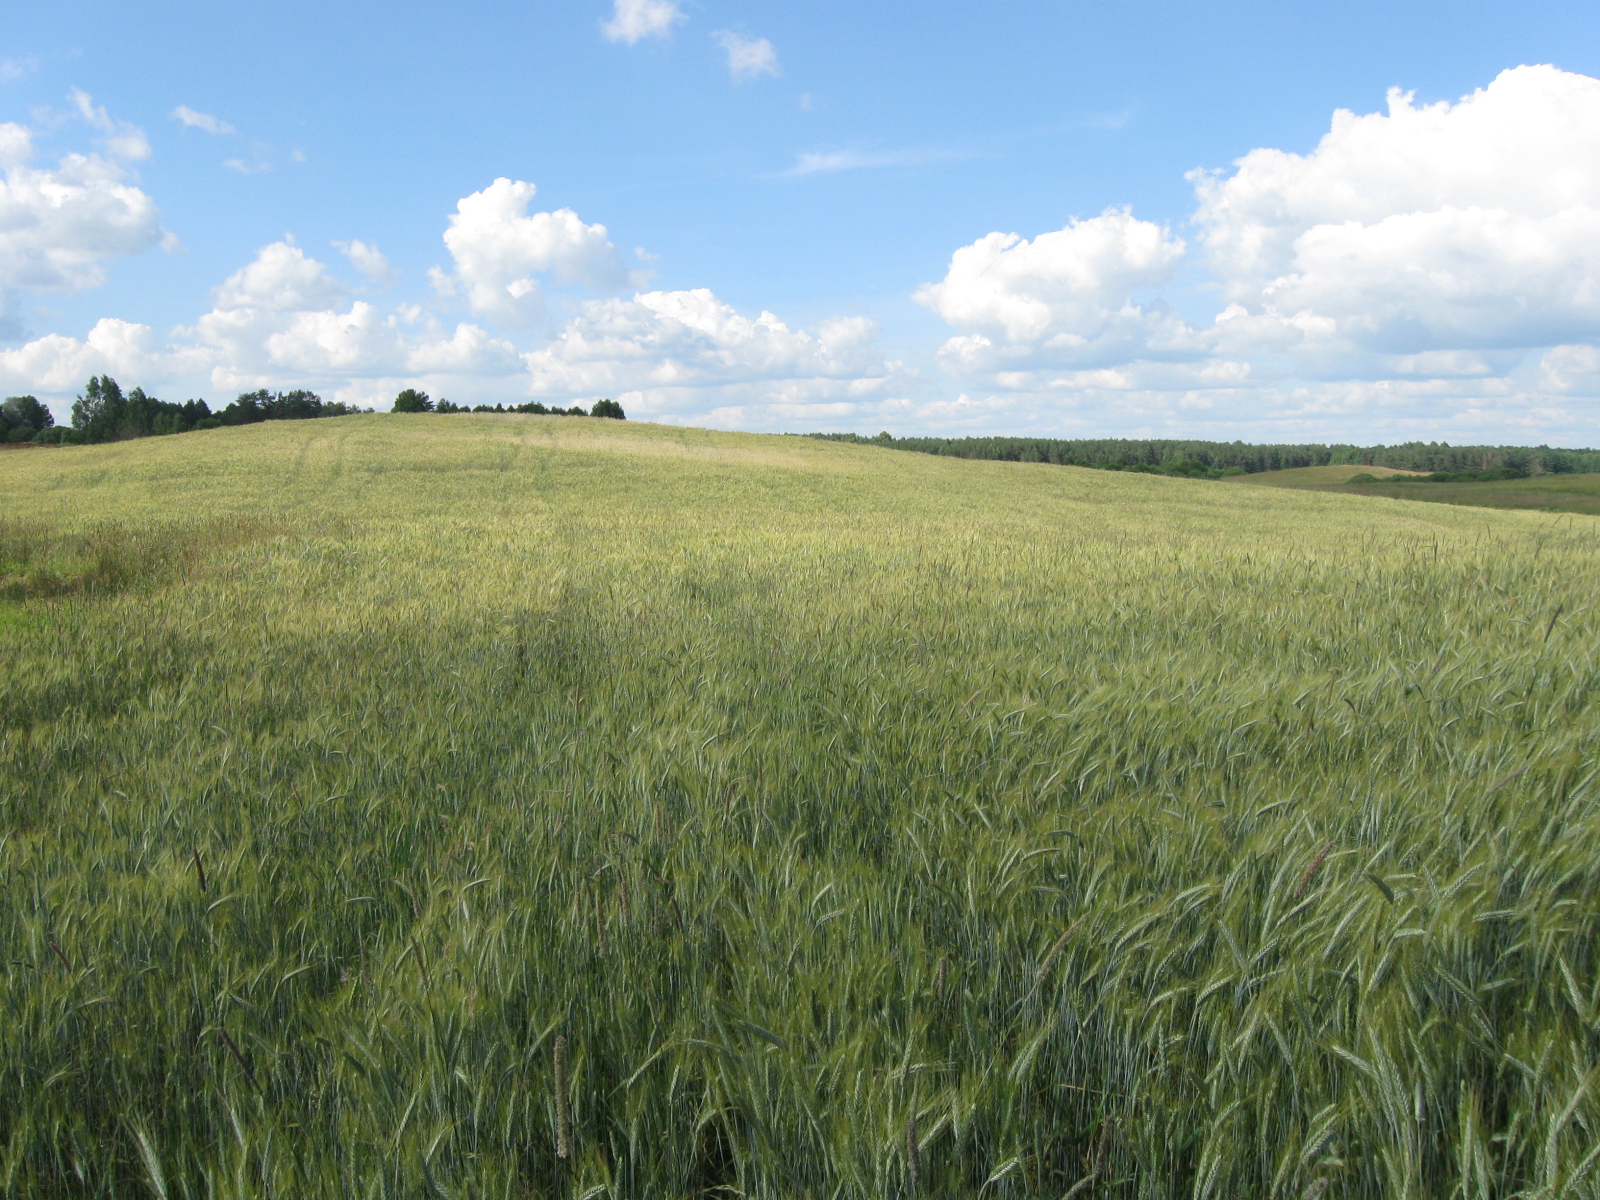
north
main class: Cropland
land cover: Triticale
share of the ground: > 75 %
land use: Agriculture (excluding fallow land and kitchen gardens)
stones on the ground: < 10 %
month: July
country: LT
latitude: 54.2477
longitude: 24.2949
